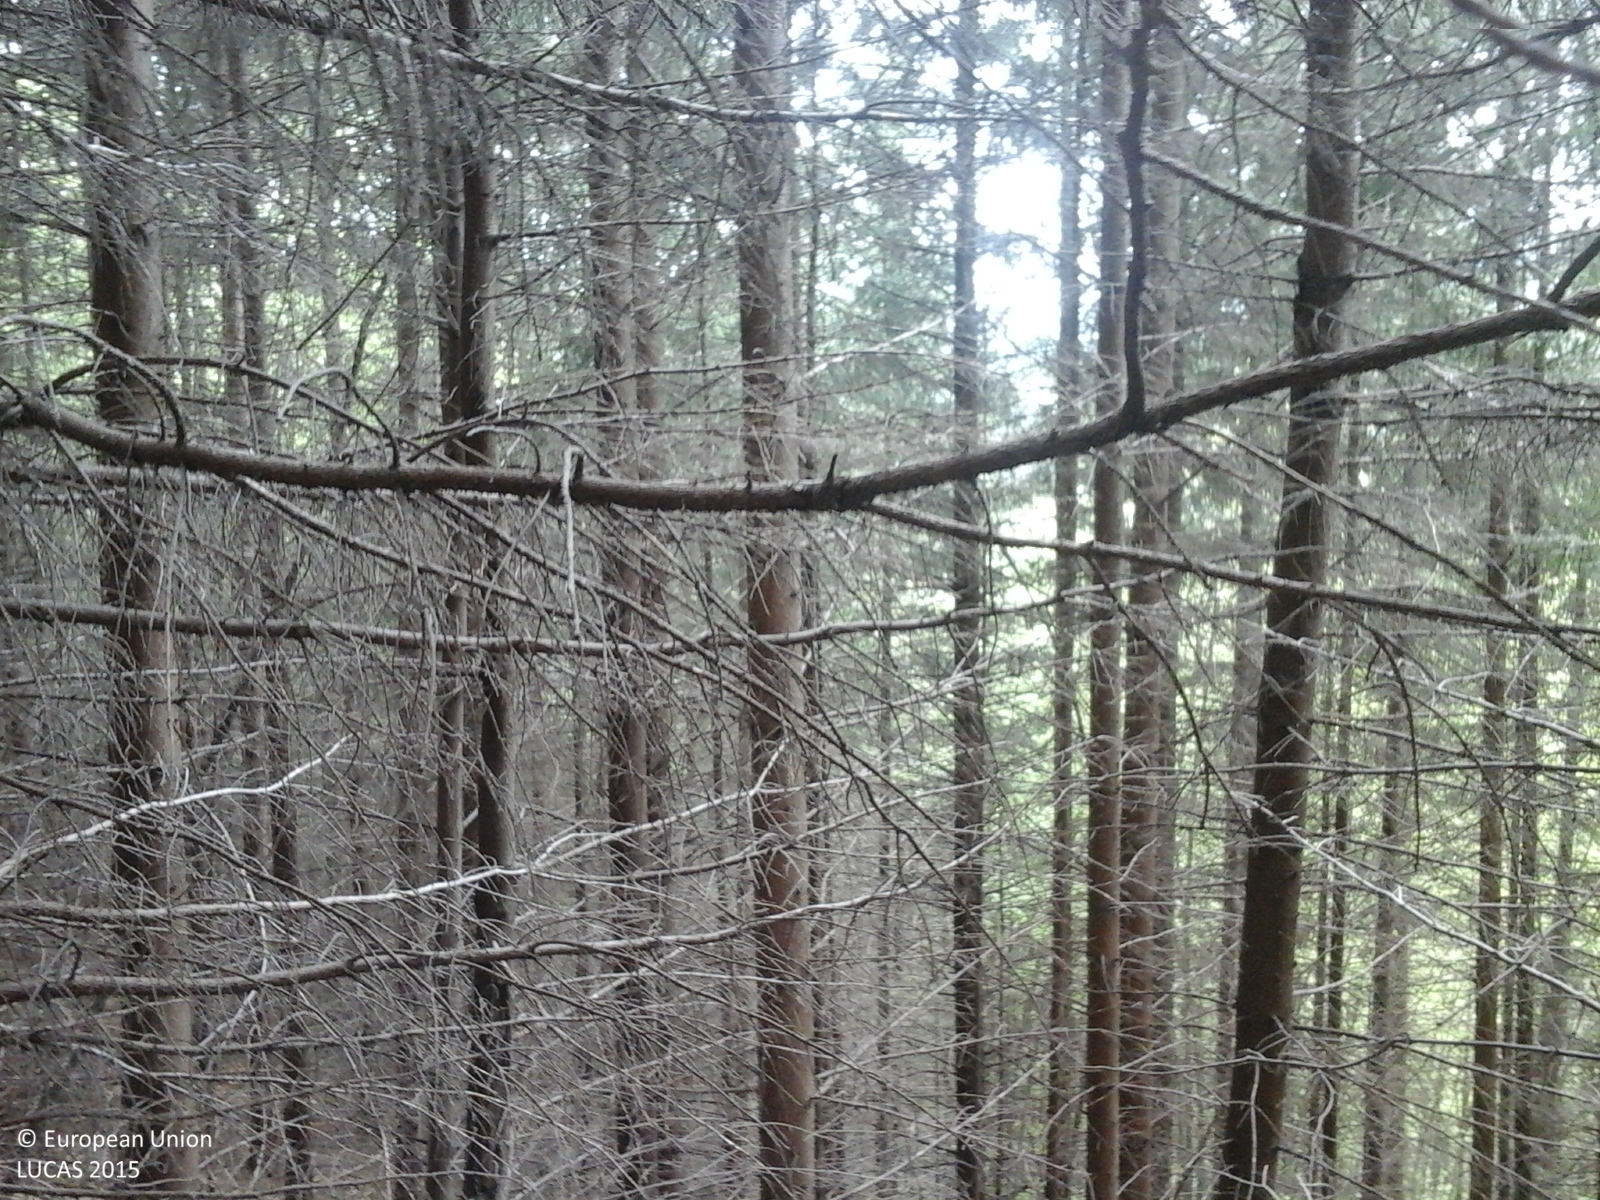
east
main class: Woodland
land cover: Spruce dominated mixed woodland
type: alpine coniferous forest
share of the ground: > 75 %
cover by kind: coniferous forest trees 50 %, broadleaved forest trees 50 %
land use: Forestry
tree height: > 5 m
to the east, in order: Spruce dominated mixed woodland; Ditches and canals; Grassland without tree/shrub cover; Spruce dominated mixed woodland
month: May
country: RO
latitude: 45.5686
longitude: 25.9362
